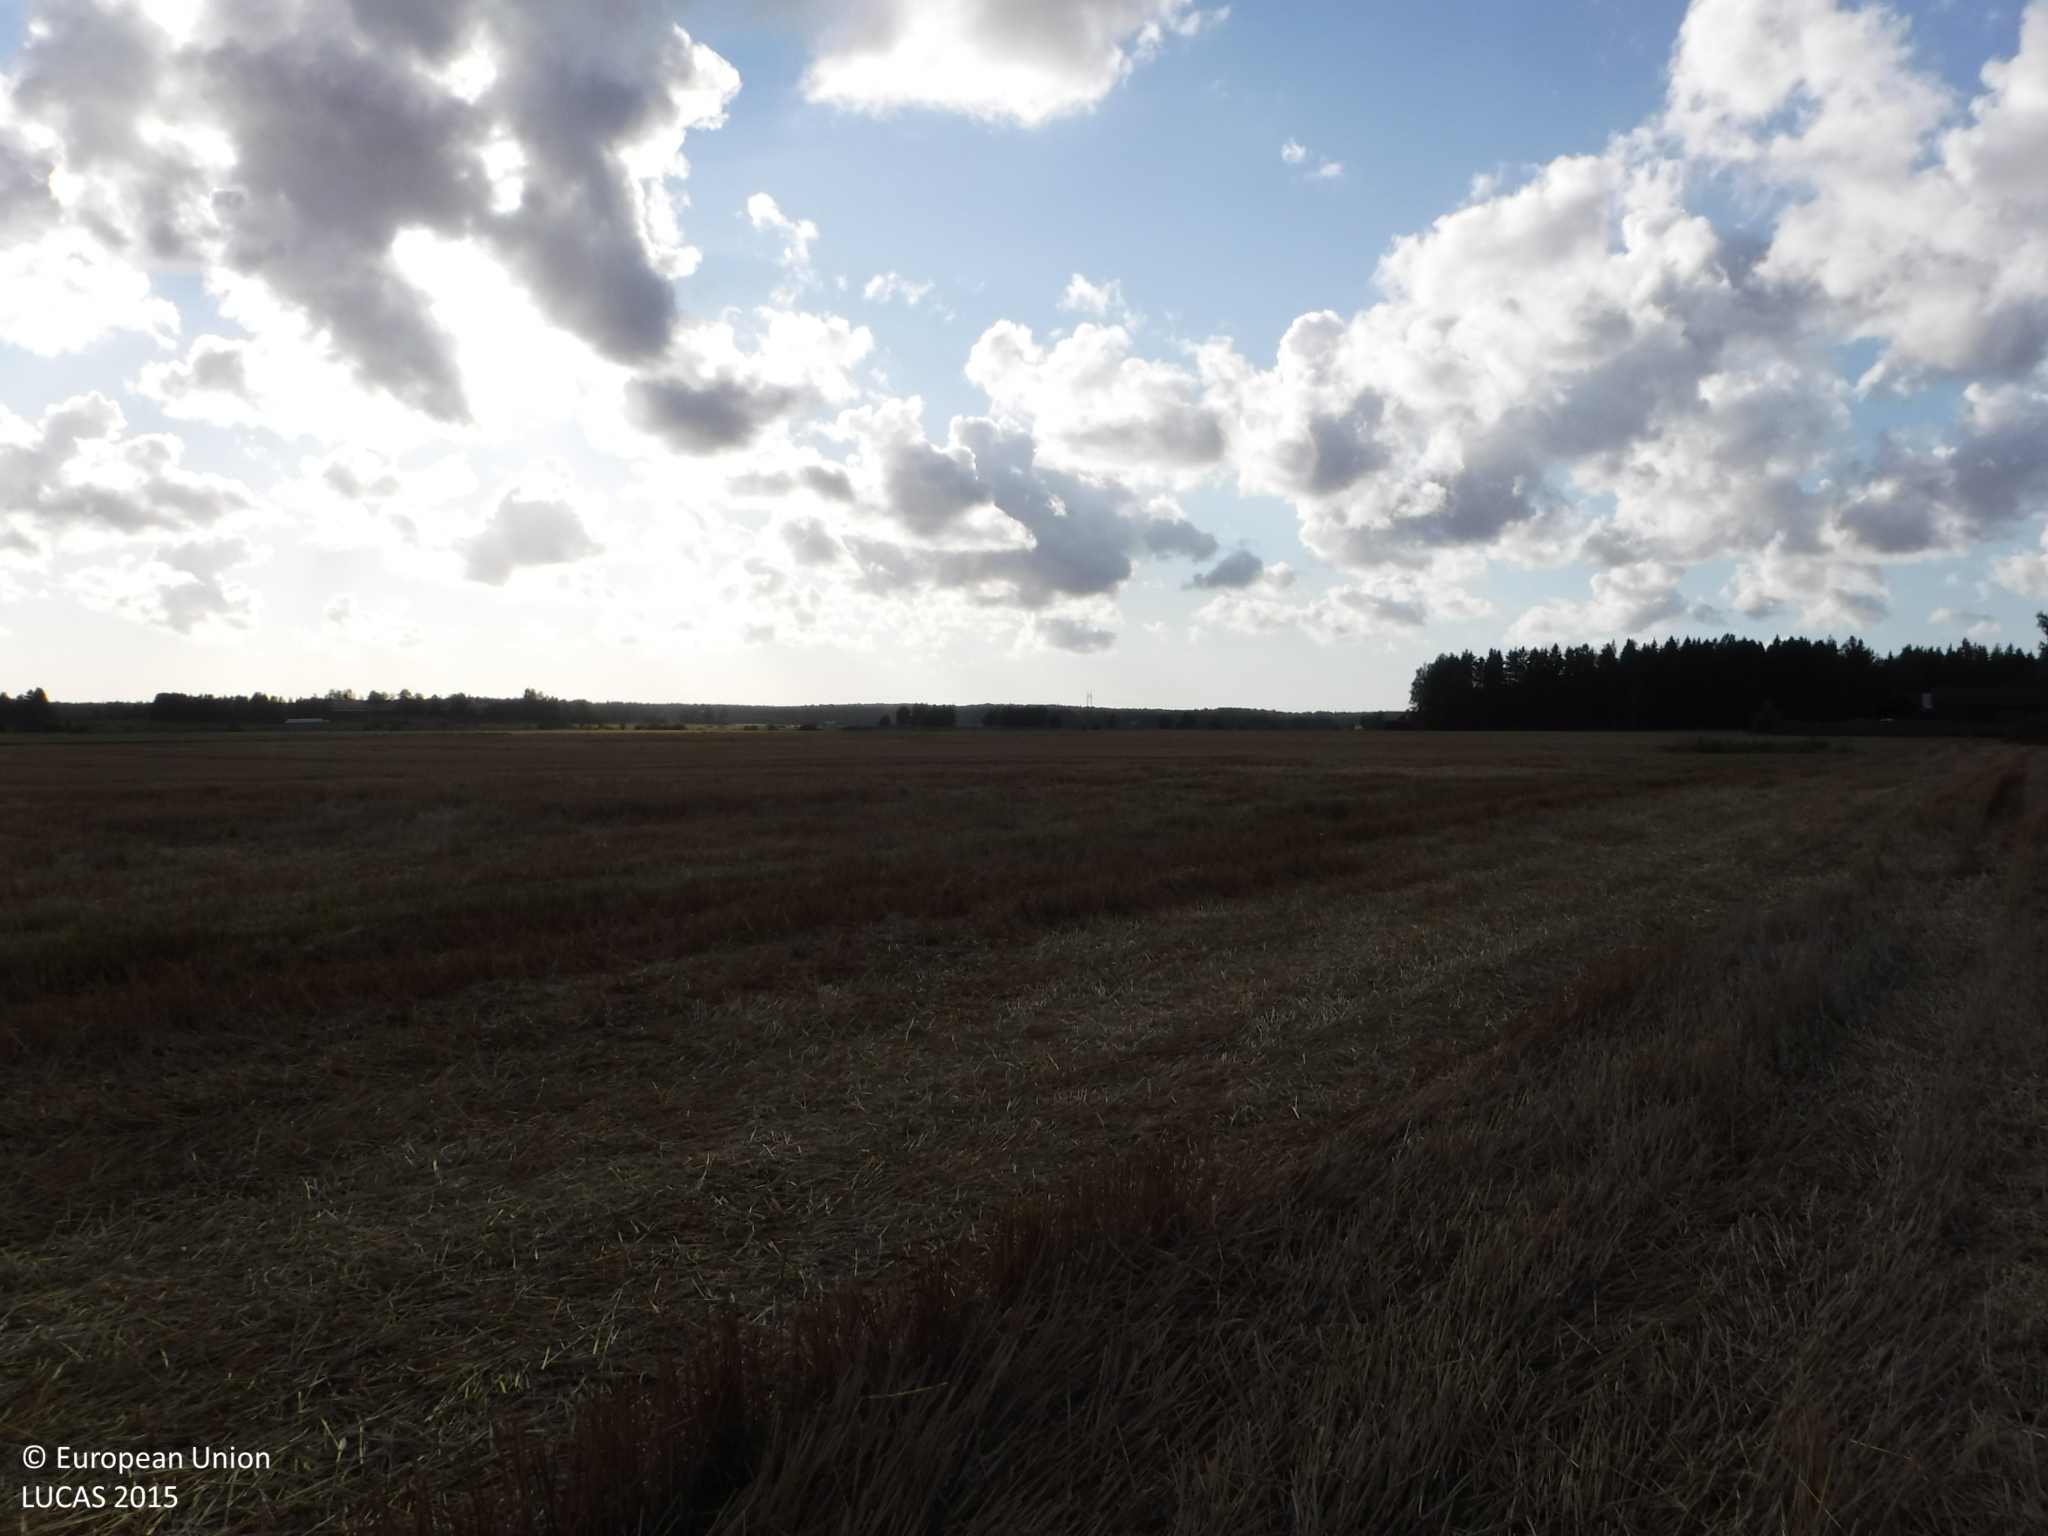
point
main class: Cropland
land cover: Rye
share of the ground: > 75 %
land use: Agriculture (excluding fallow land and kitchen gardens)
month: August
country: FI
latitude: 61.2471
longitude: 22.0794
